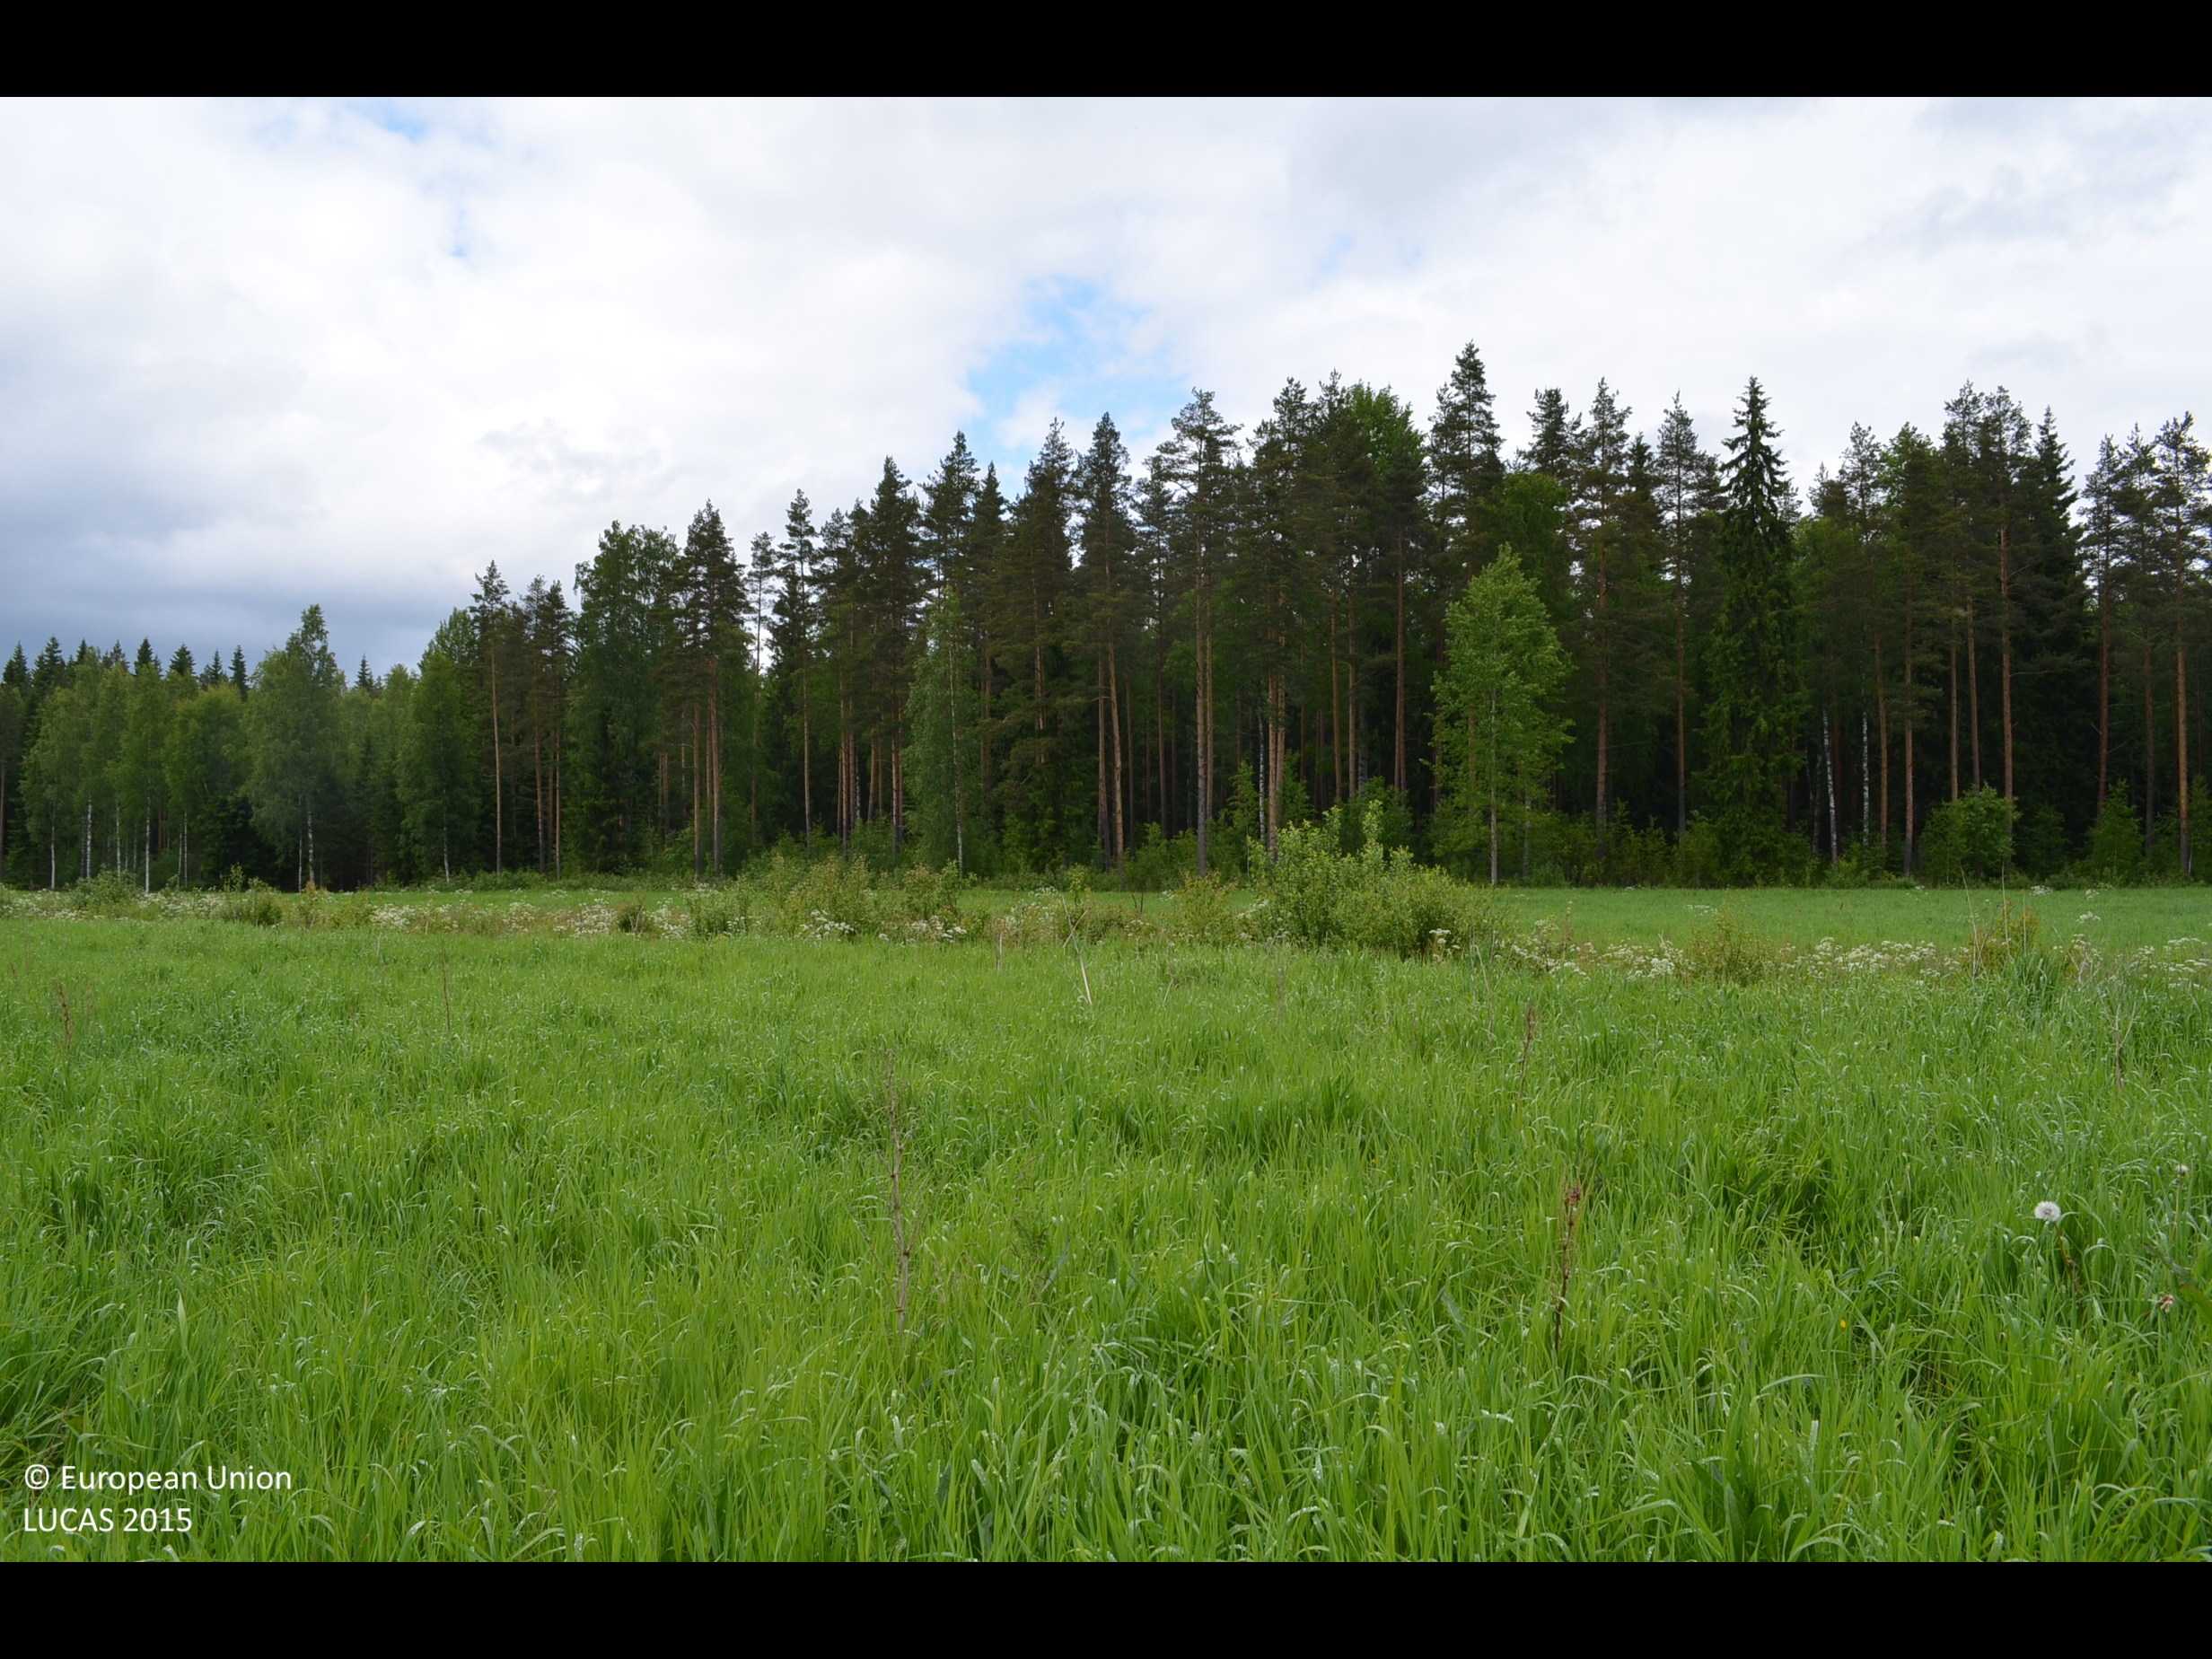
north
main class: Cropland
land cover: Temporary grasslands
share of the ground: > 75 %
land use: Agriculture (excluding fallow land and kitchen gardens)
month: June
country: FI
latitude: 61.7432
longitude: 23.3095
